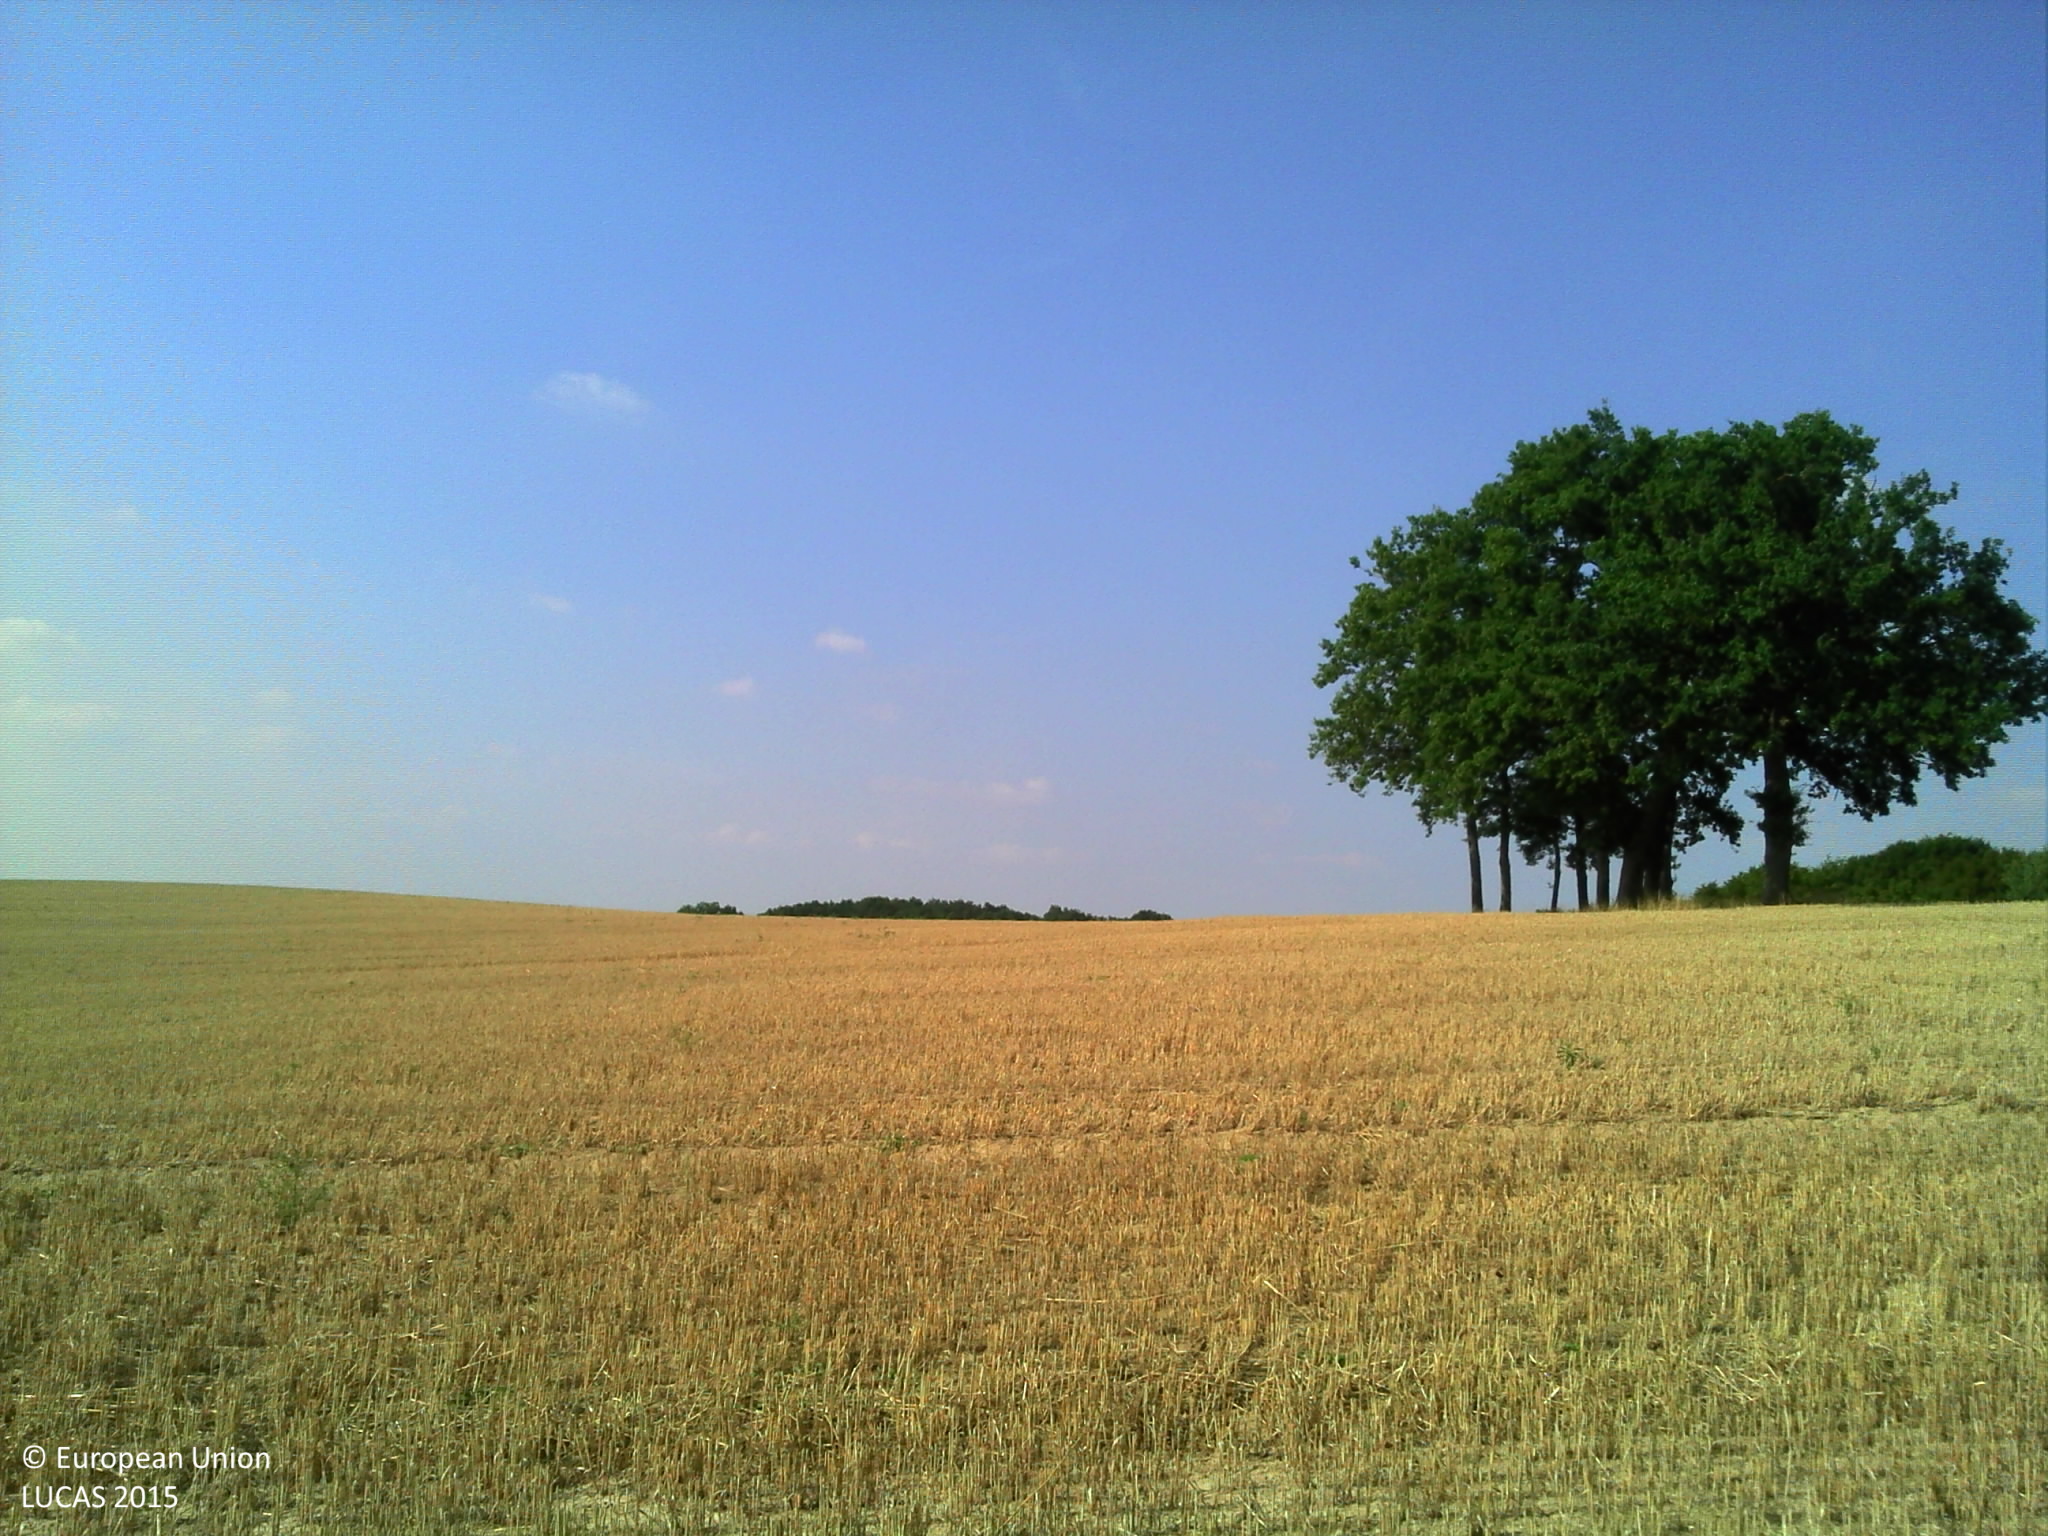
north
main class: Cropland
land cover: Common wheat
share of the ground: > 75 %
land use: Agriculture (excluding fallow land and kitchen gardens)
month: August
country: FR
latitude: 46.3952
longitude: 3.6139
